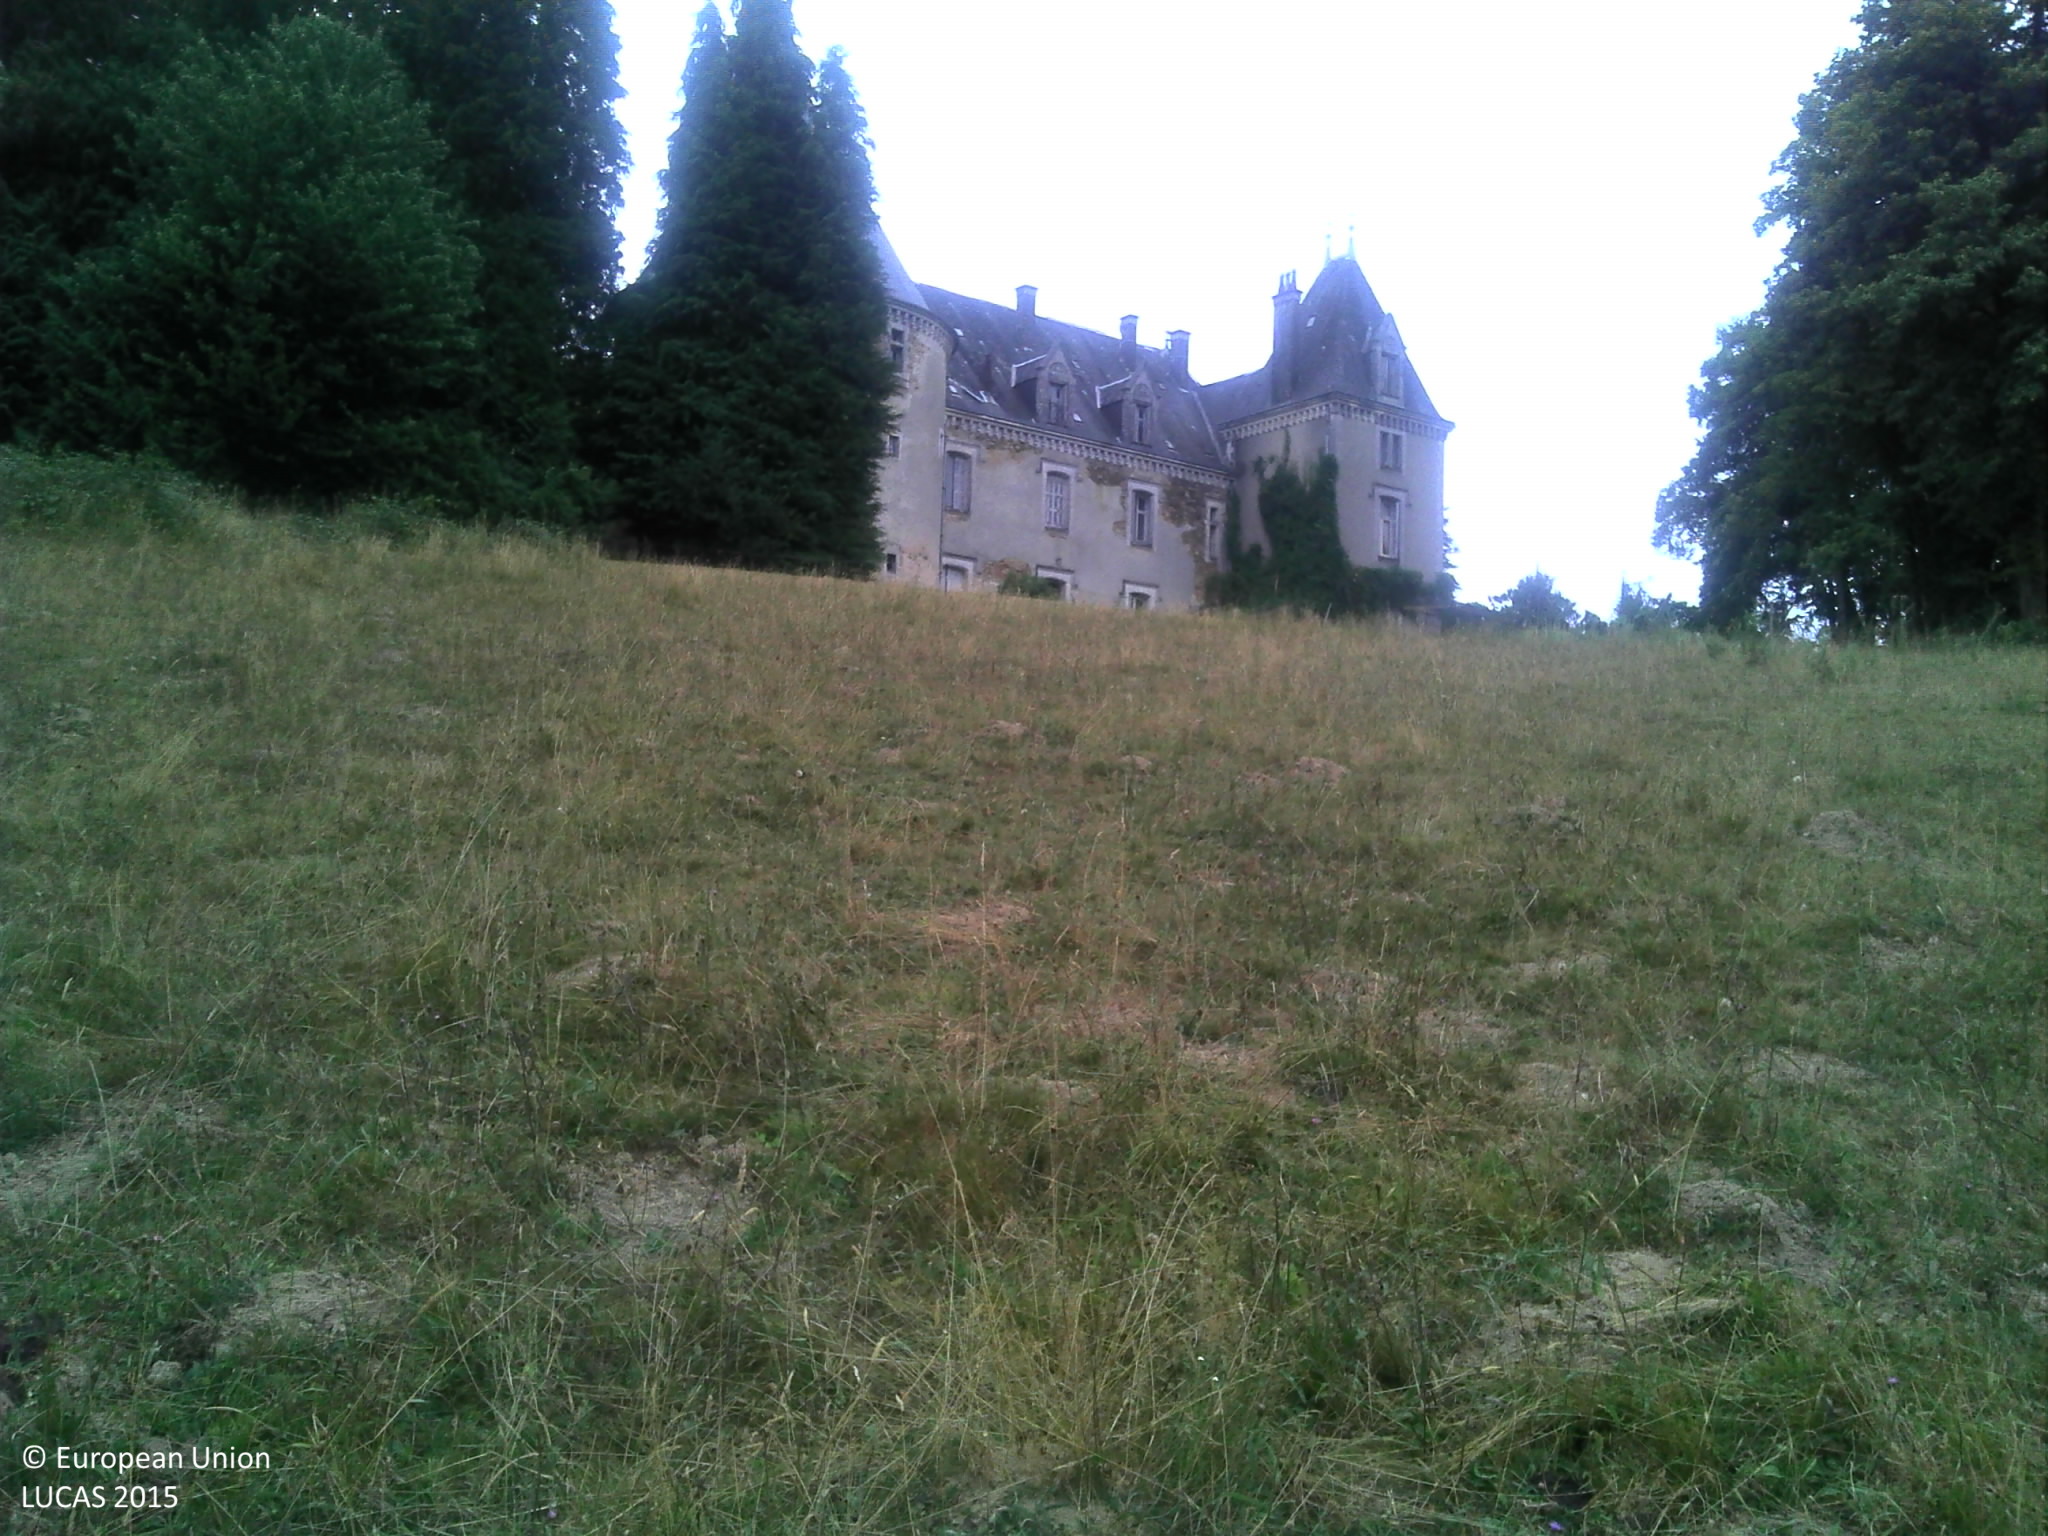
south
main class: Grassland
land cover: Grassland without tree/shrub cover
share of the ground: > 75 %
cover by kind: herbaceous plants 100 %
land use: Agriculture (excluding fallow land and kitchen gardens)
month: July
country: FR
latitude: 45.5218
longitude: 1.4797
